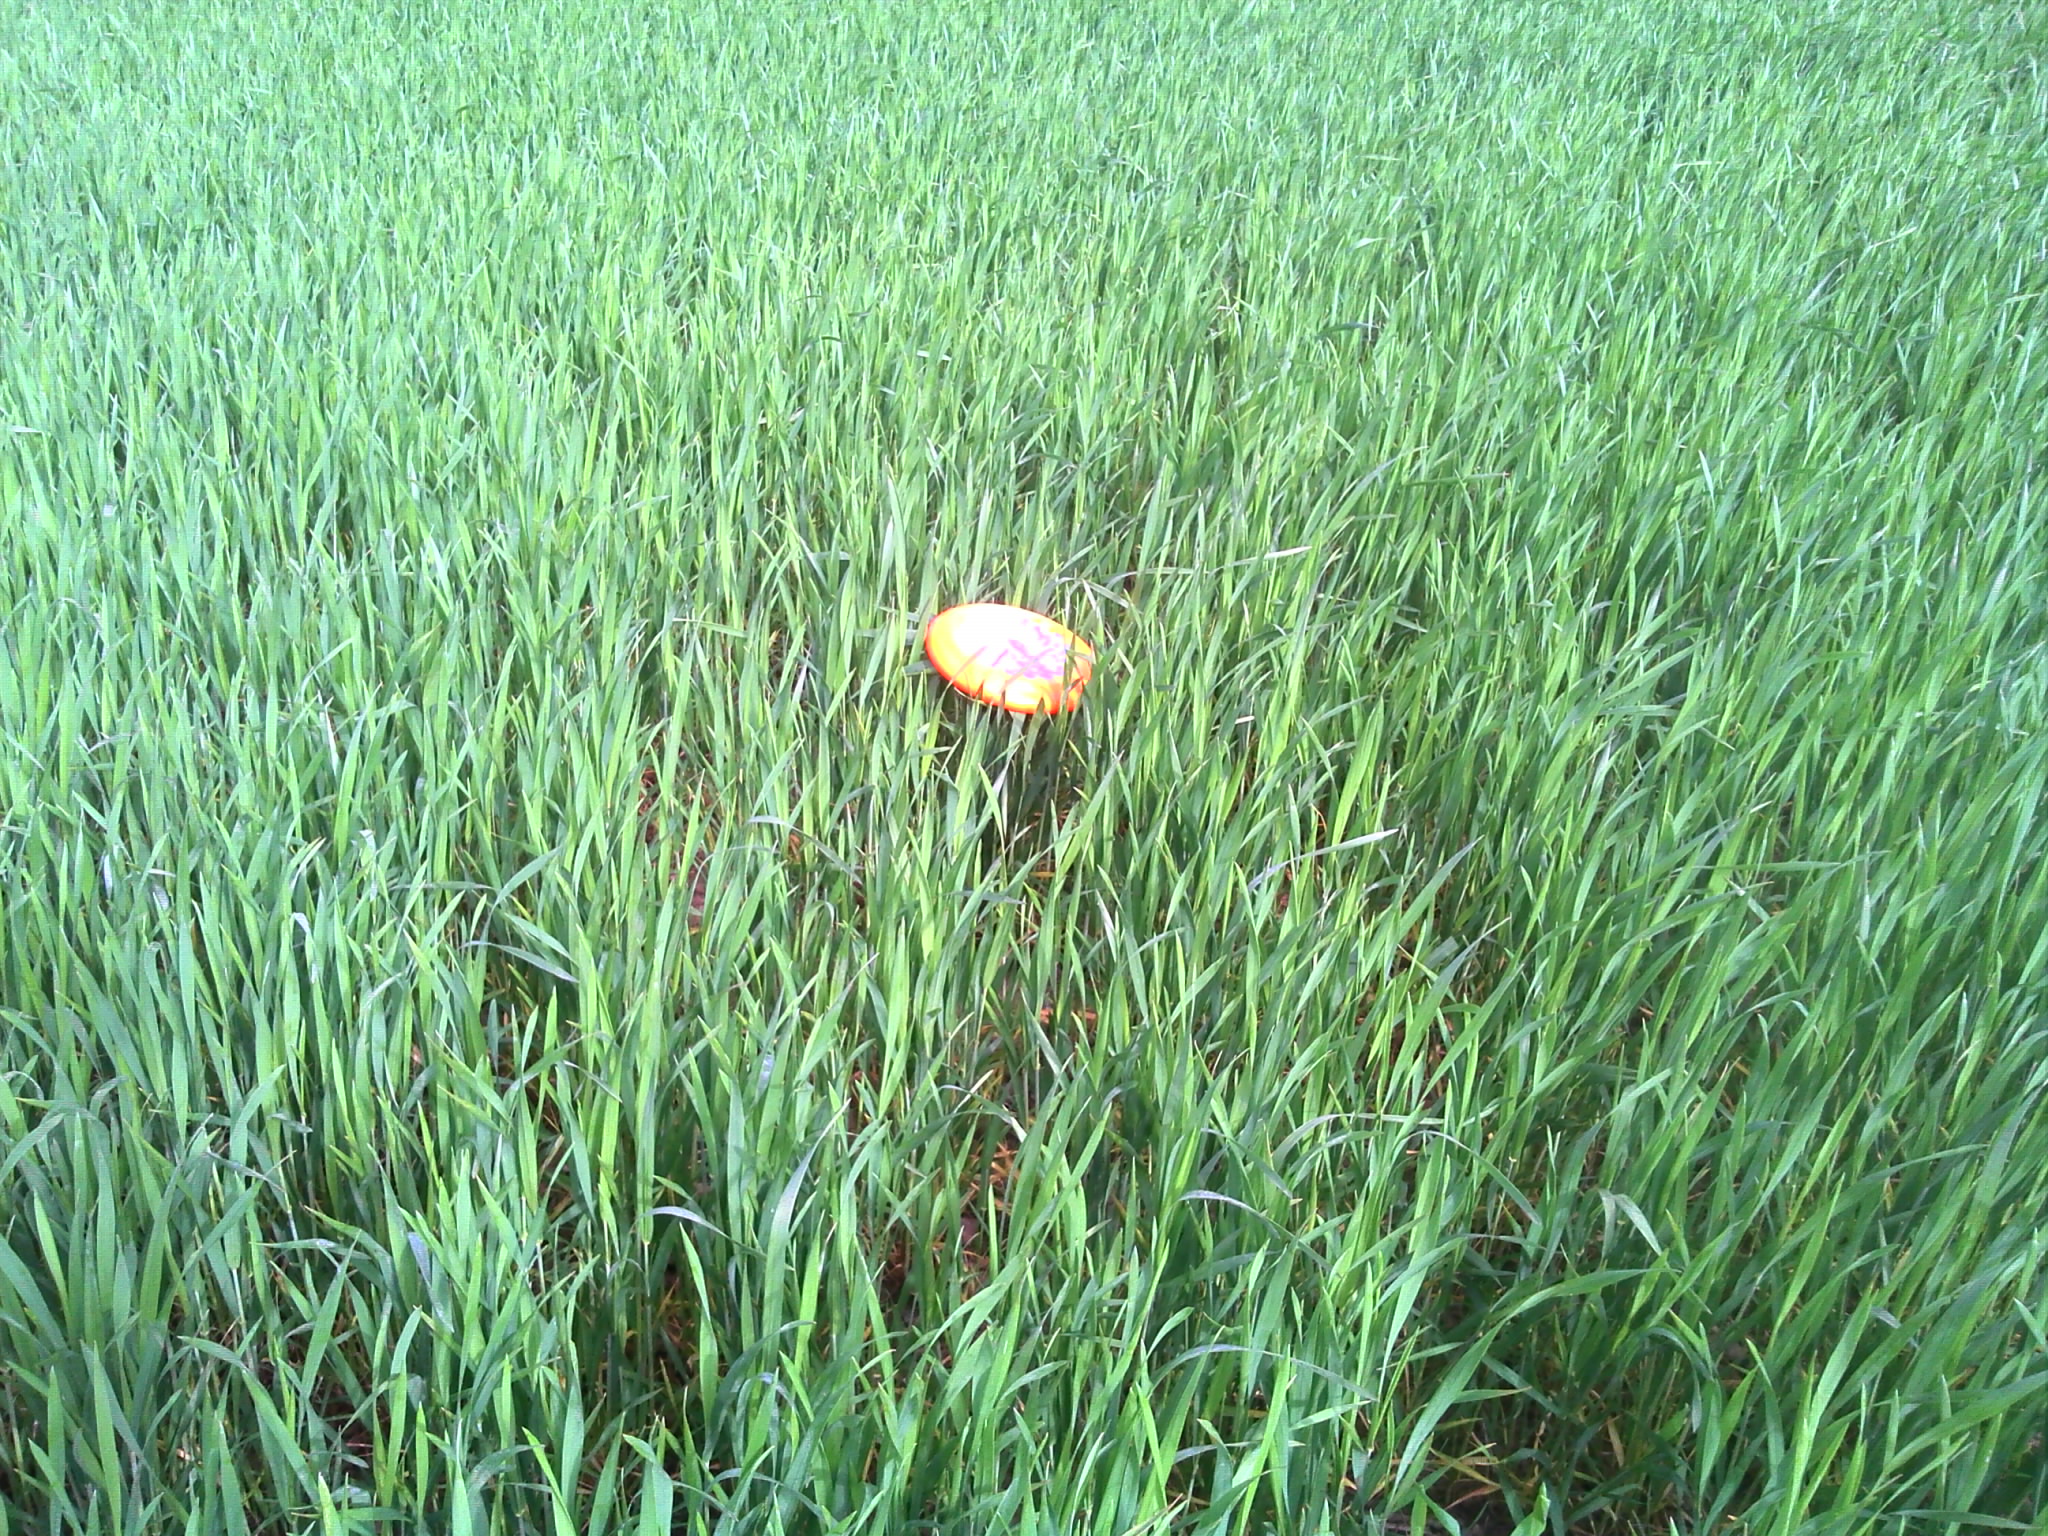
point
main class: Cropland
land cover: Common wheat
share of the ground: > 75 %
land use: Agriculture (excluding fallow land and kitchen gardens)
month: May
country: LU
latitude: 50.0199
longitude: 5.8817
